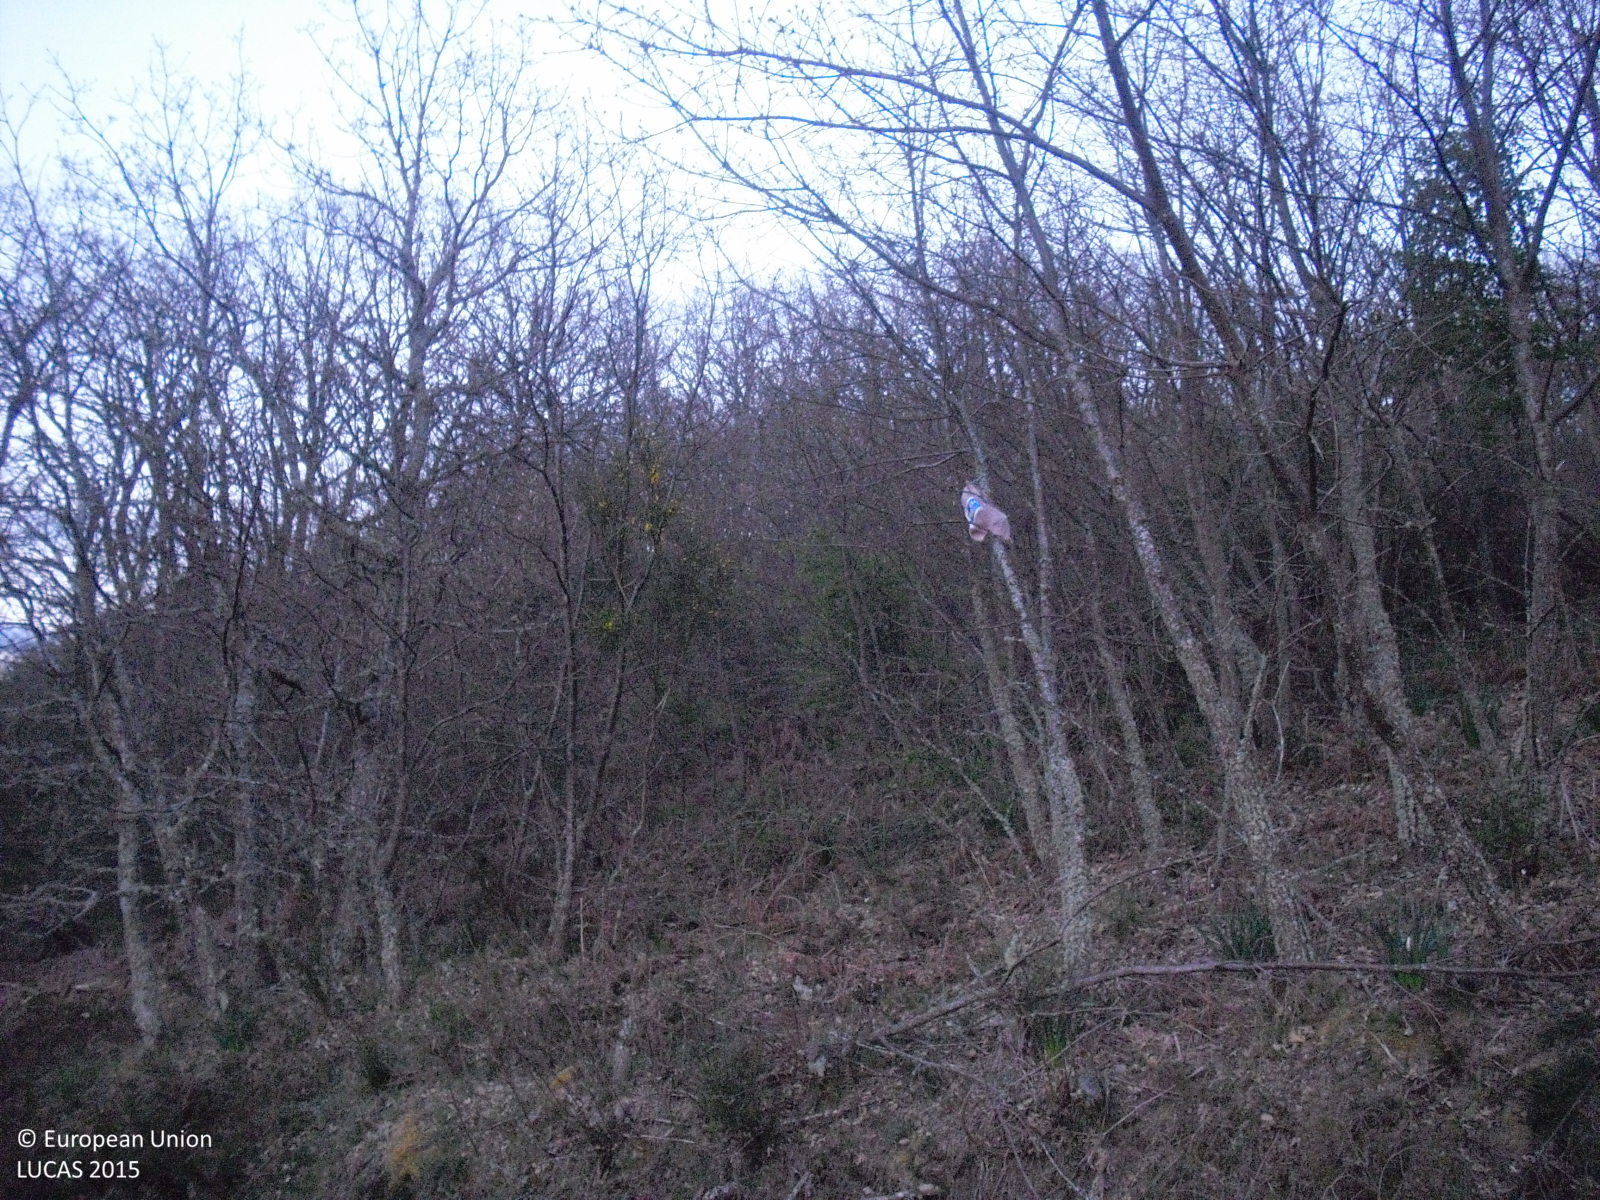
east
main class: Woodland
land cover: Broadleaved woodland
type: thermophilous deciduous forest
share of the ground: 50 - 75 %
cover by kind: broadleaved forest trees 60 %, shrubs 30 %, herbaceous plants 10 %
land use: Forestry
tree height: < 5 m
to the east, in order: Broadleaved woodland; Tracks; Broadleaved woodland; Paved roads, cycling and walking lanes; Grass margins; Ditches and canals; Shruby margins; Broadleaved woodland; Electric lines; Broadleaved woodland; Dry stone walls; Broadleaved woodland; Dry stone walls; Broadleaved woodland
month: April
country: ES
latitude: 41.9713
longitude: -7.7723
